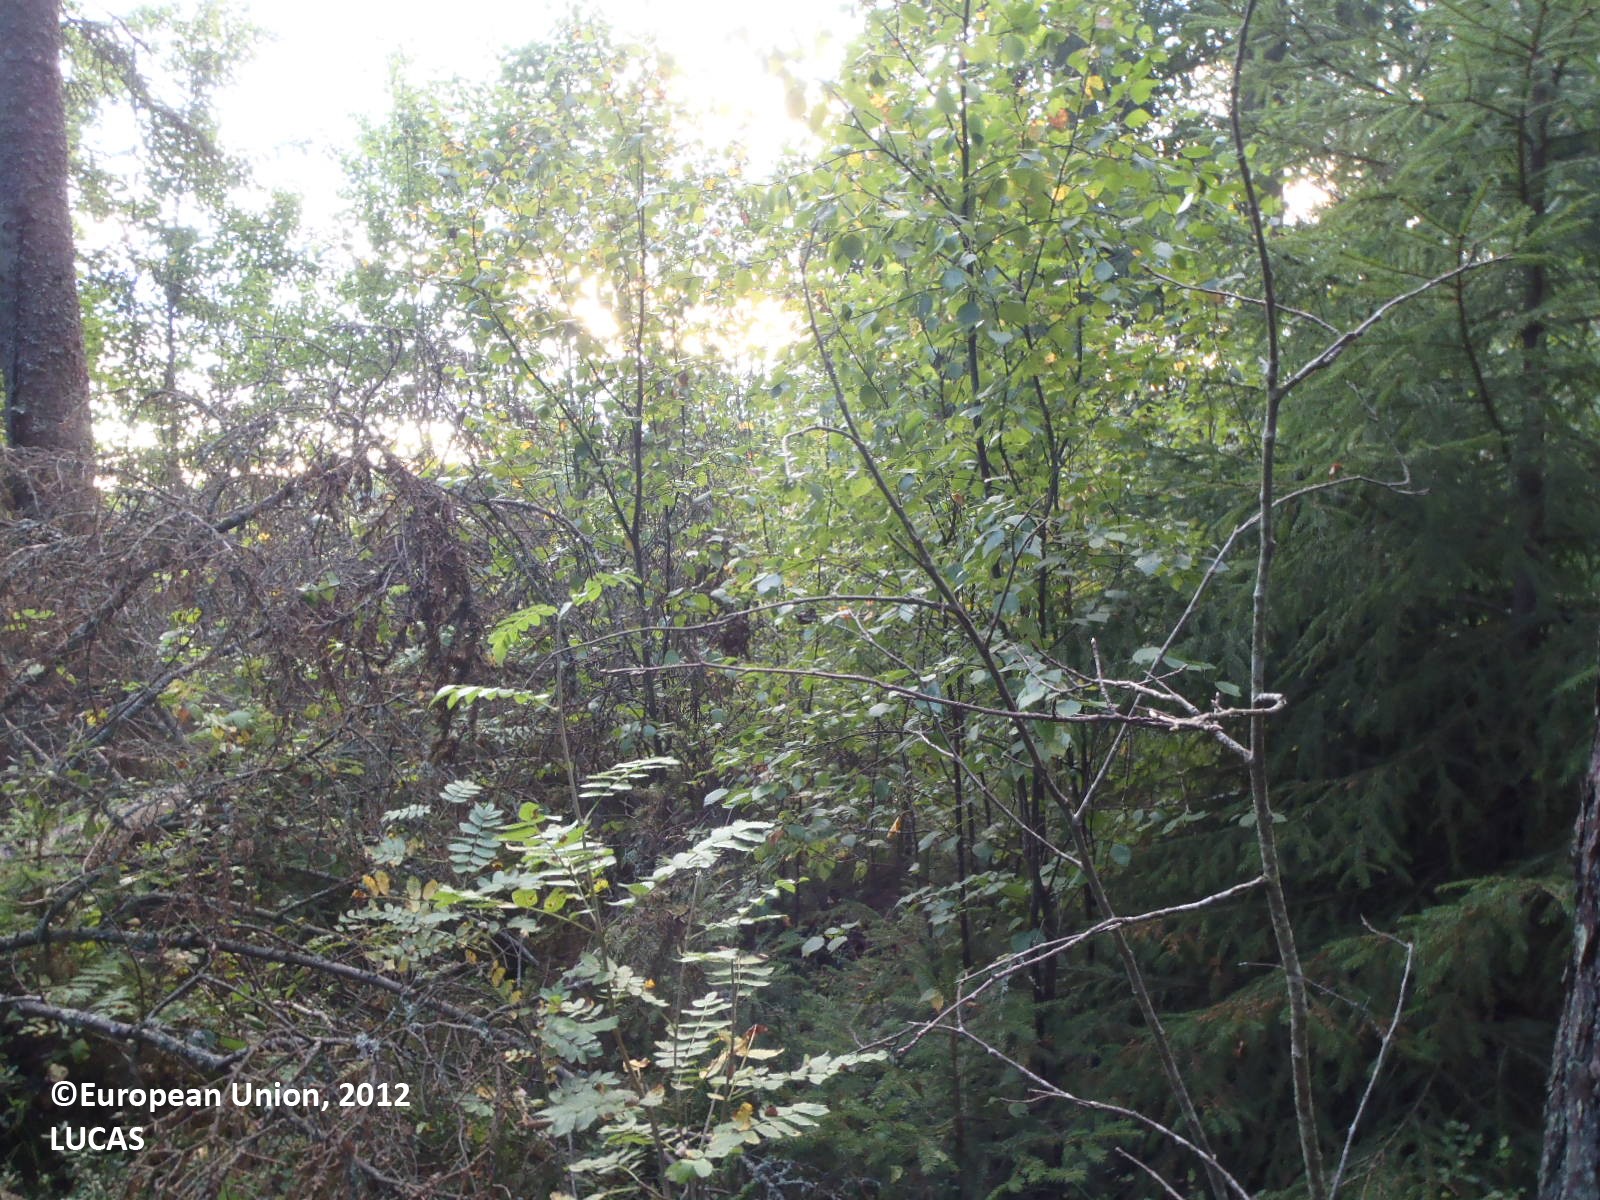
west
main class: Woodland
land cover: Other coniferous woodland
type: boreal forest
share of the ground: > 75 %
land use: Forestry
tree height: > 5 m
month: August
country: FI
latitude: 60.6023
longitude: 22.3585
